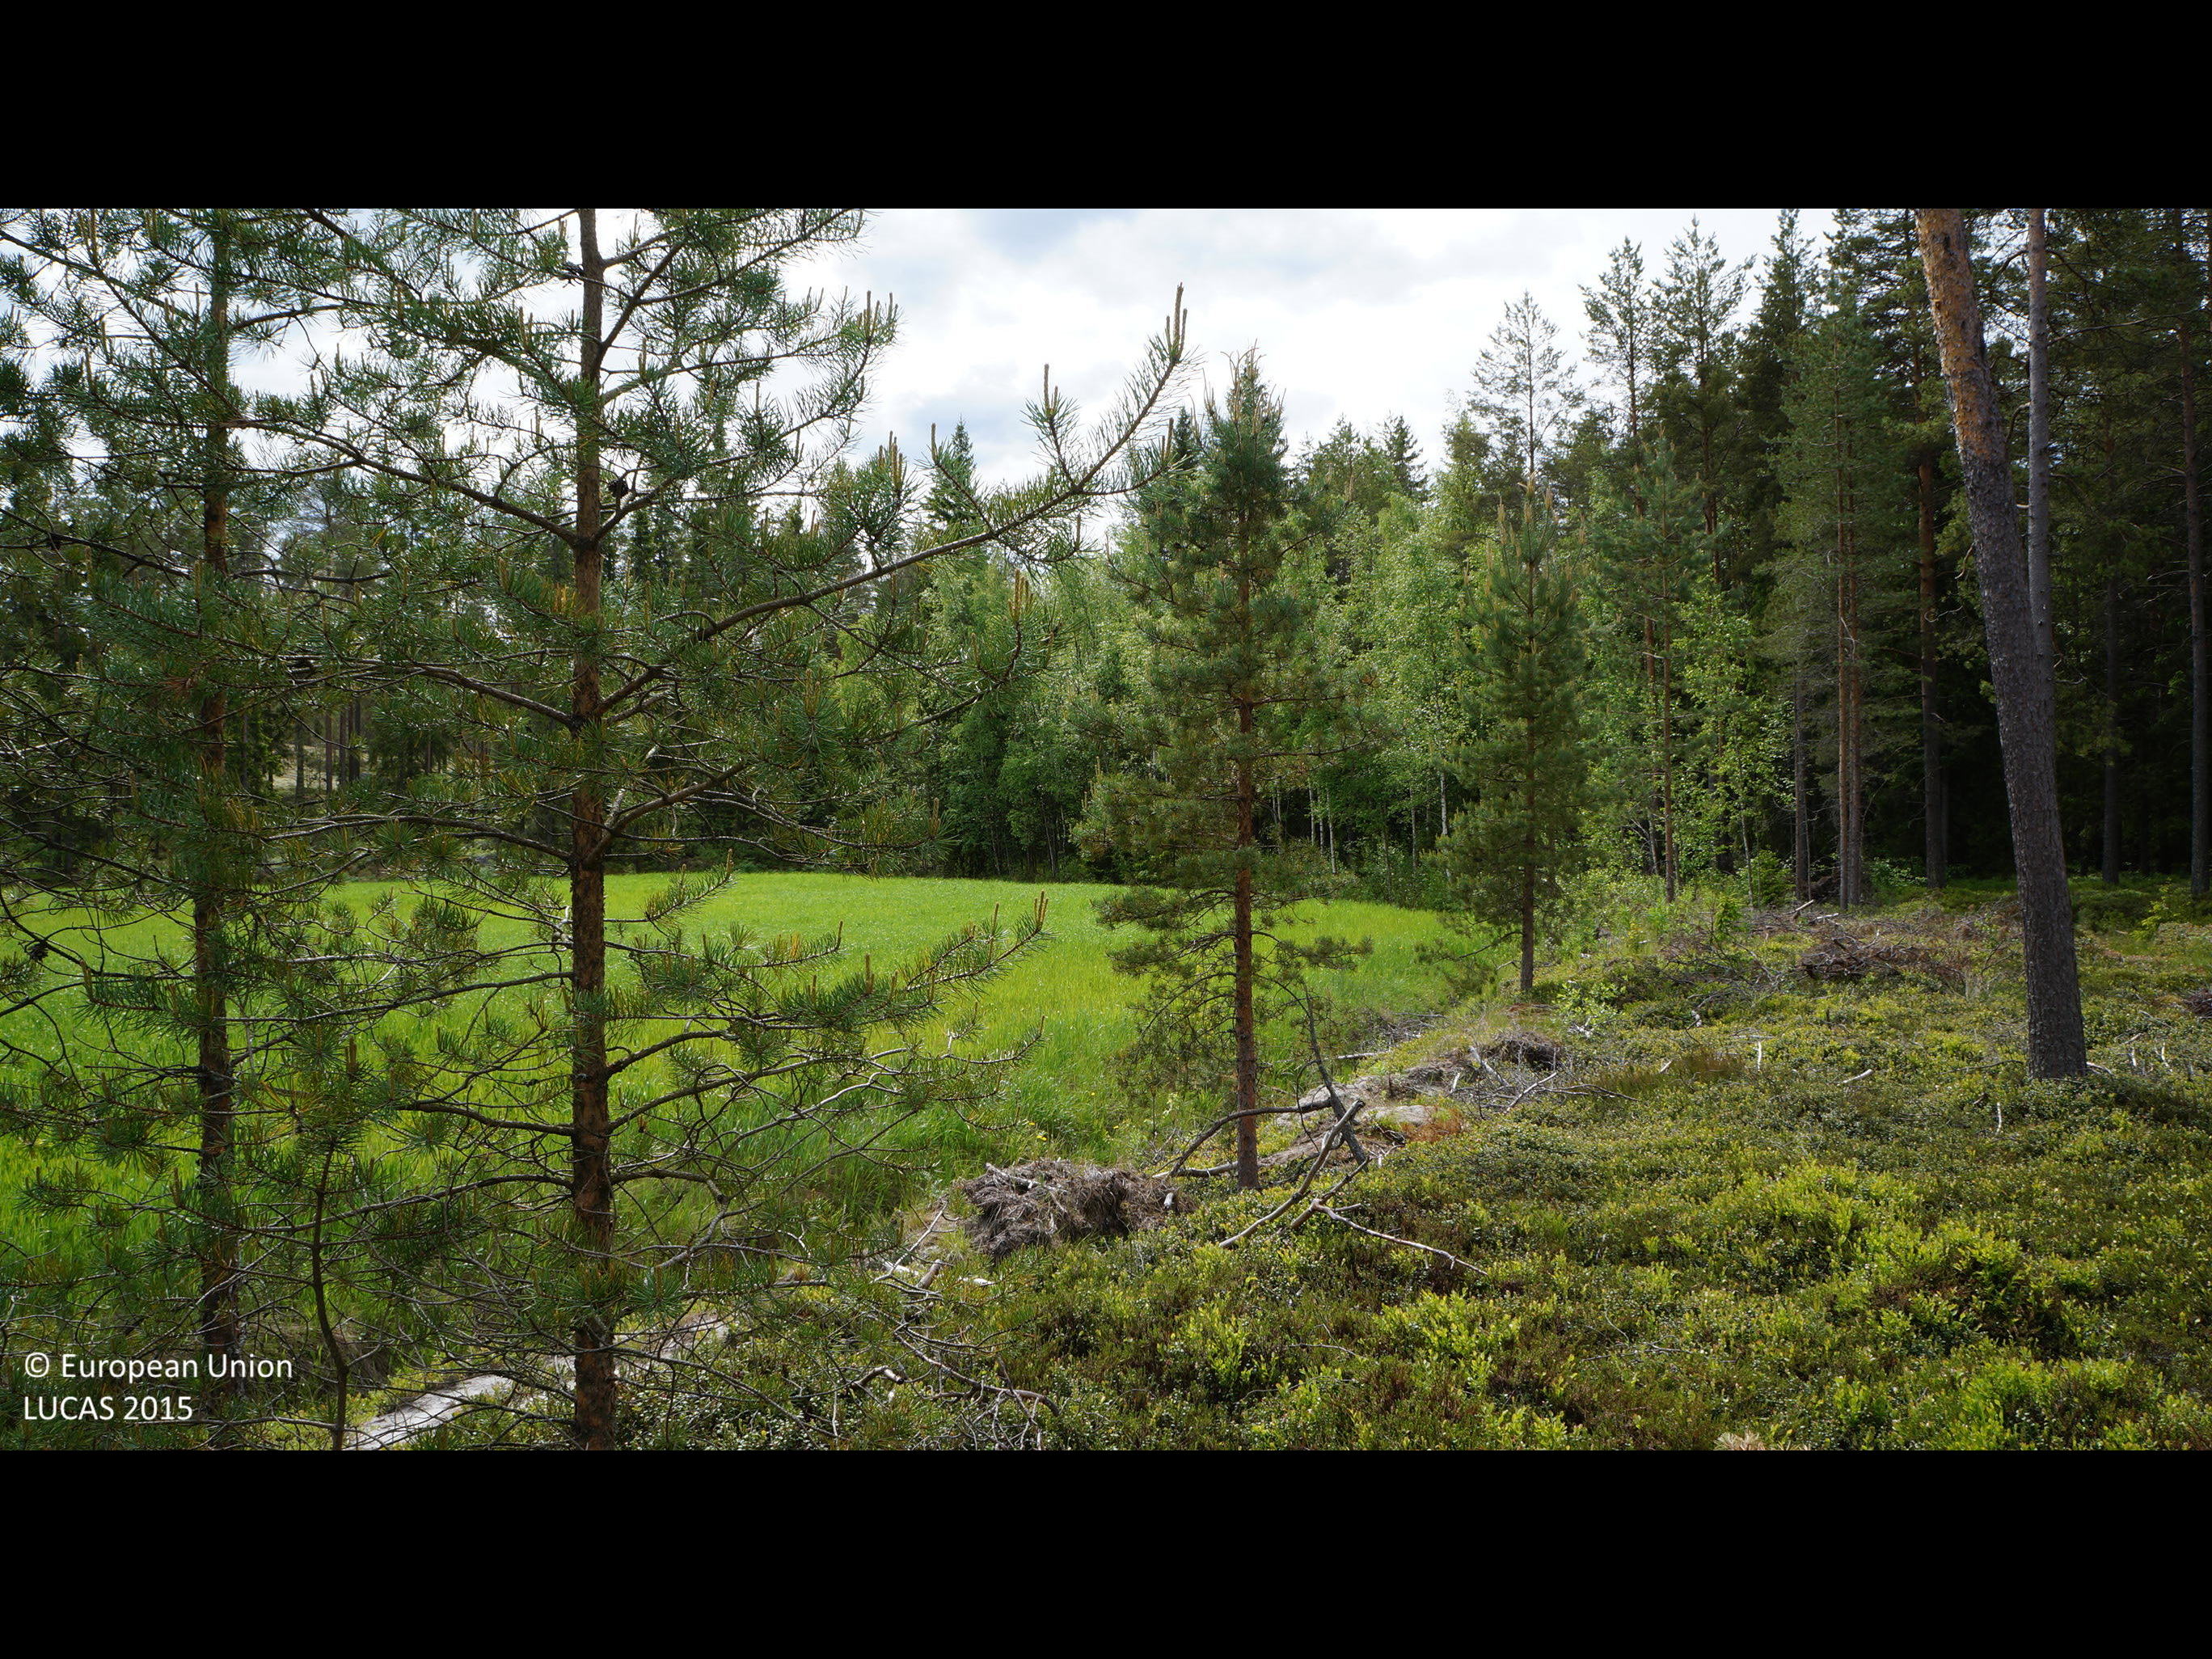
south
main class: Woodland
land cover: Pine dominated coniferous woodland
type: boreal forest
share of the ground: 50 - 75 %
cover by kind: coniferous forest trees 70 %, herbaceous plants 15 %, shrubs 10 %, lichens and mosses 5 %
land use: Forestry
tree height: > 5 m
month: June
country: FI
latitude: 63.9707
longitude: 23.4343
